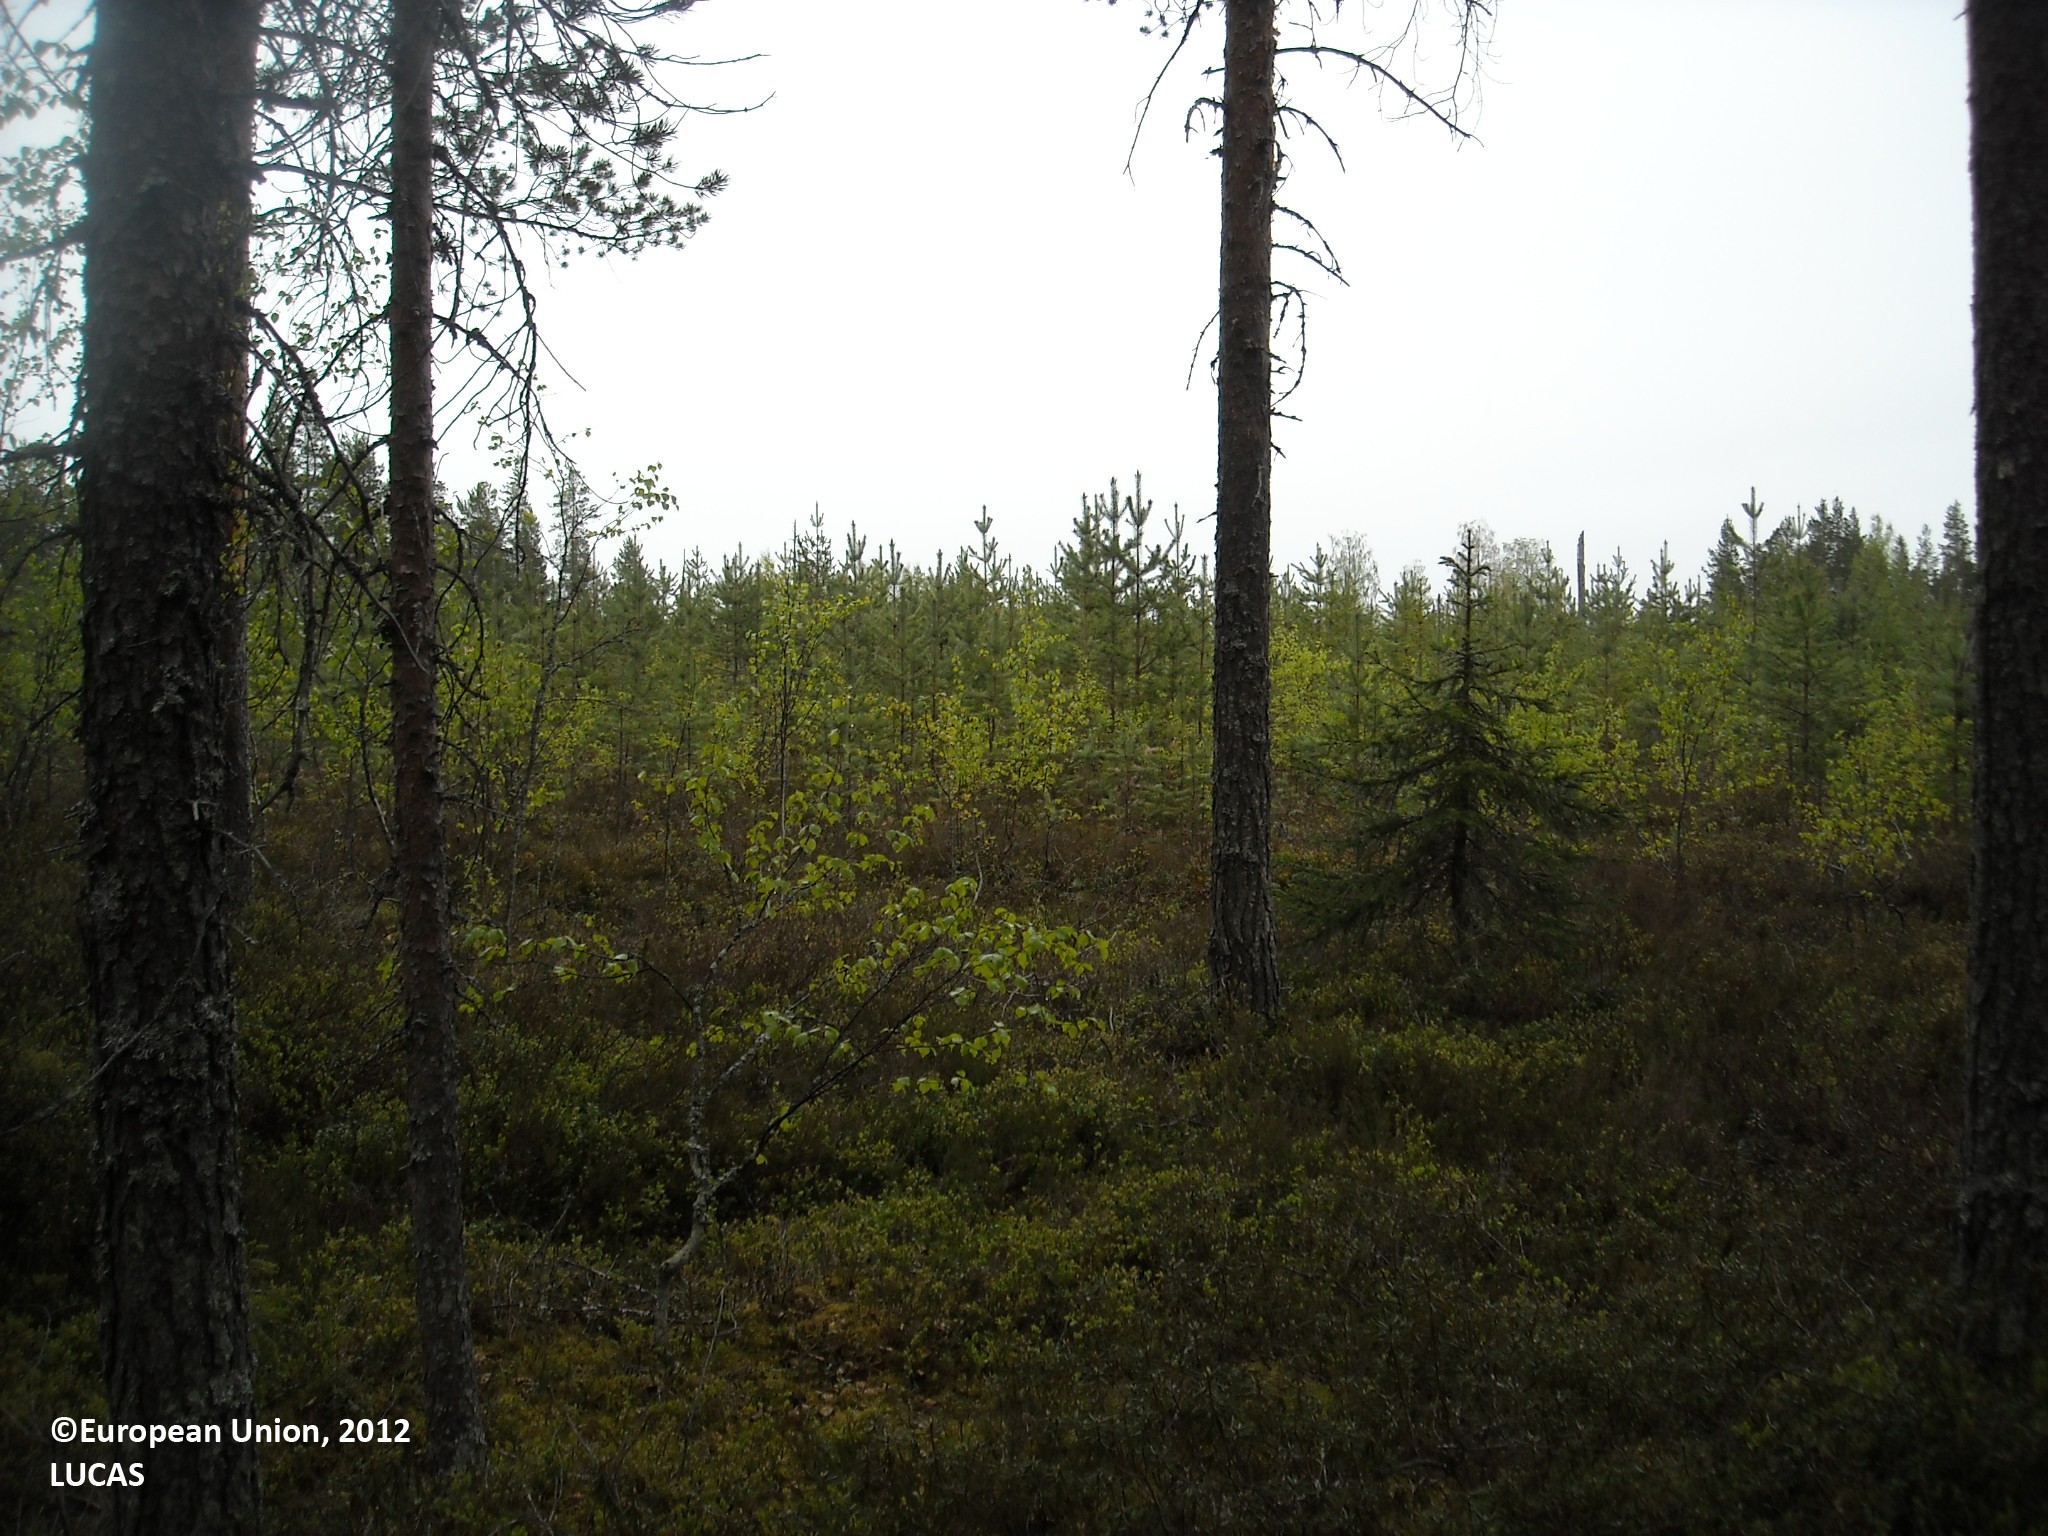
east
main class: Woodland
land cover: Pine dominated mixed woodland
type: boreal forest
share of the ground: > 75 %
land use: Forestry
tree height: > 5 m
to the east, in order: Pine dominated mixed woodland; Ditches and canals; Shrubland with sparse tree cover; Pine dominated coniferous woodland; Pine dominated mixed woodland; Ditches and canals; Grass margins; Paved roads, cycling and walking lanes; Grass margins; Ditches and canals; Pine dominated mixed woodland; Pine dominated coniferous woodland; Ditches and canals; Pine dominated coniferous woodland
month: June
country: FI
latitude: 64.6521
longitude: 27.2370
